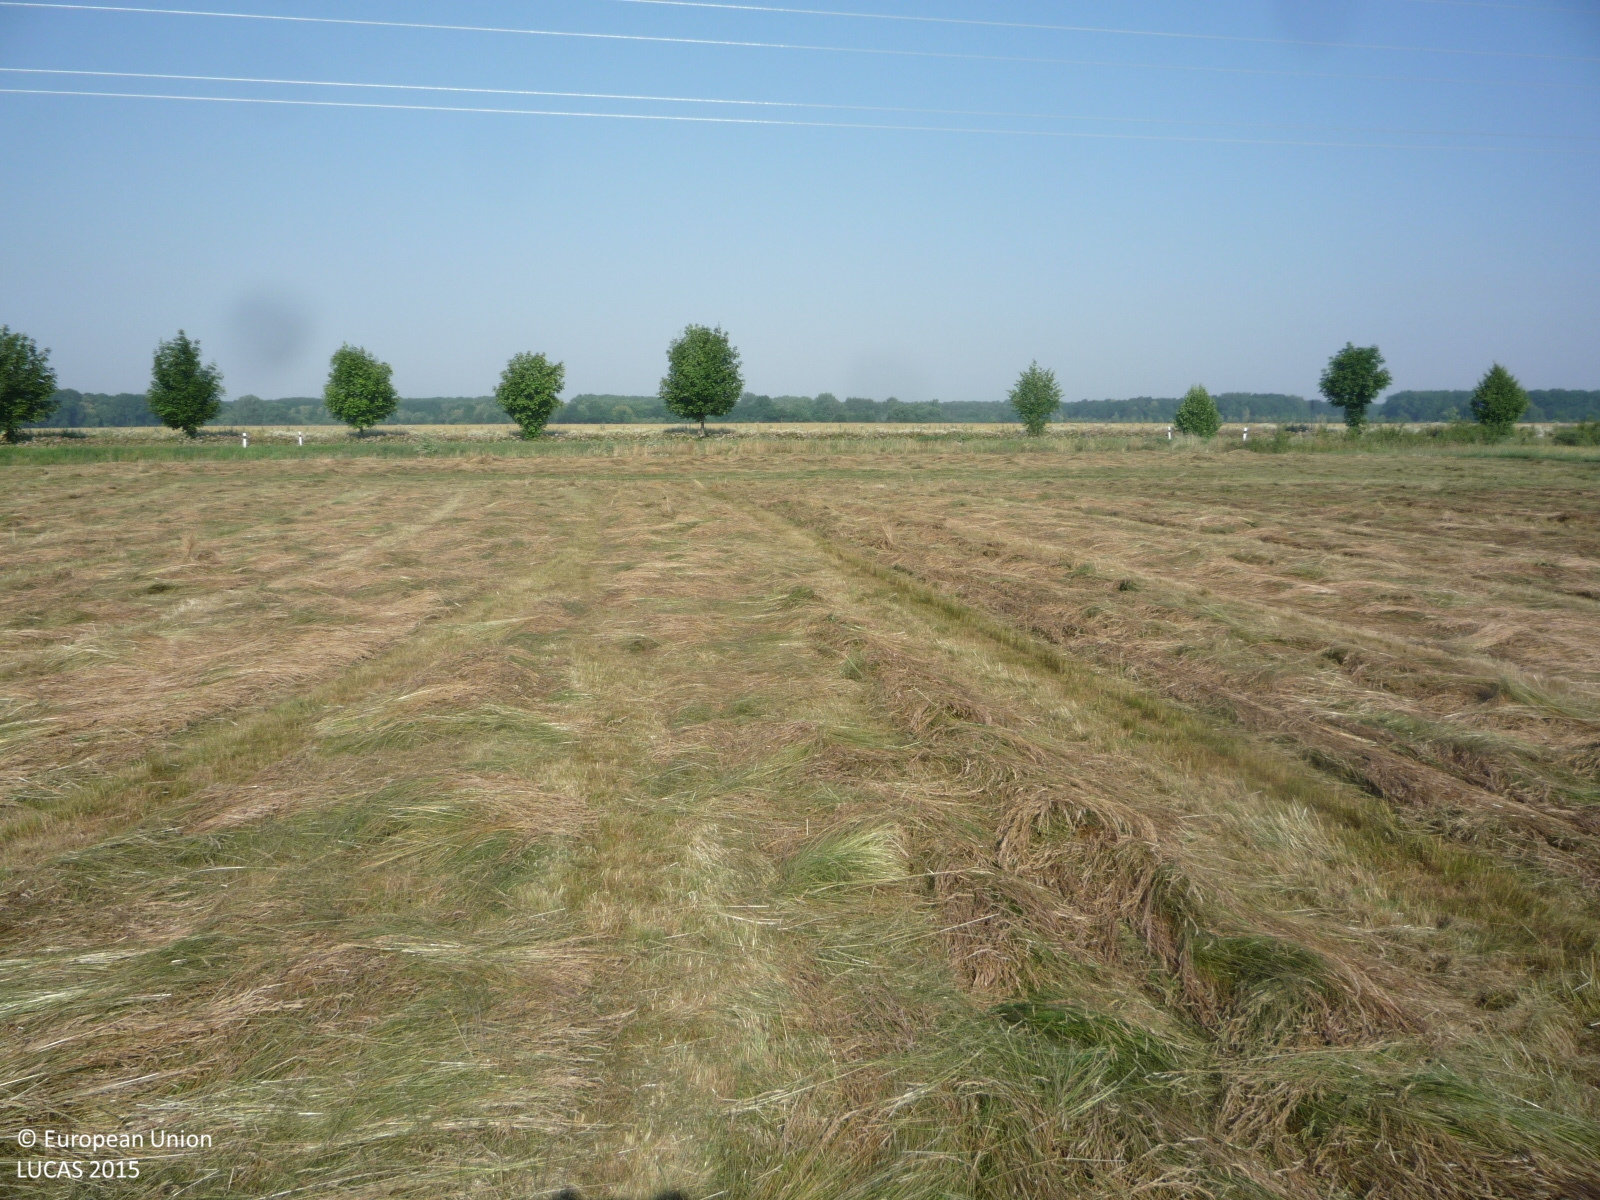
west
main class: Grassland
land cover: Grassland without tree/shrub cover
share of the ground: > 75 %
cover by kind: herbaceous plants 100 %
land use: Agriculture (excluding fallow land and kitchen gardens)
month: July
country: CZ
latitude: 50.0842
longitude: 15.1881
